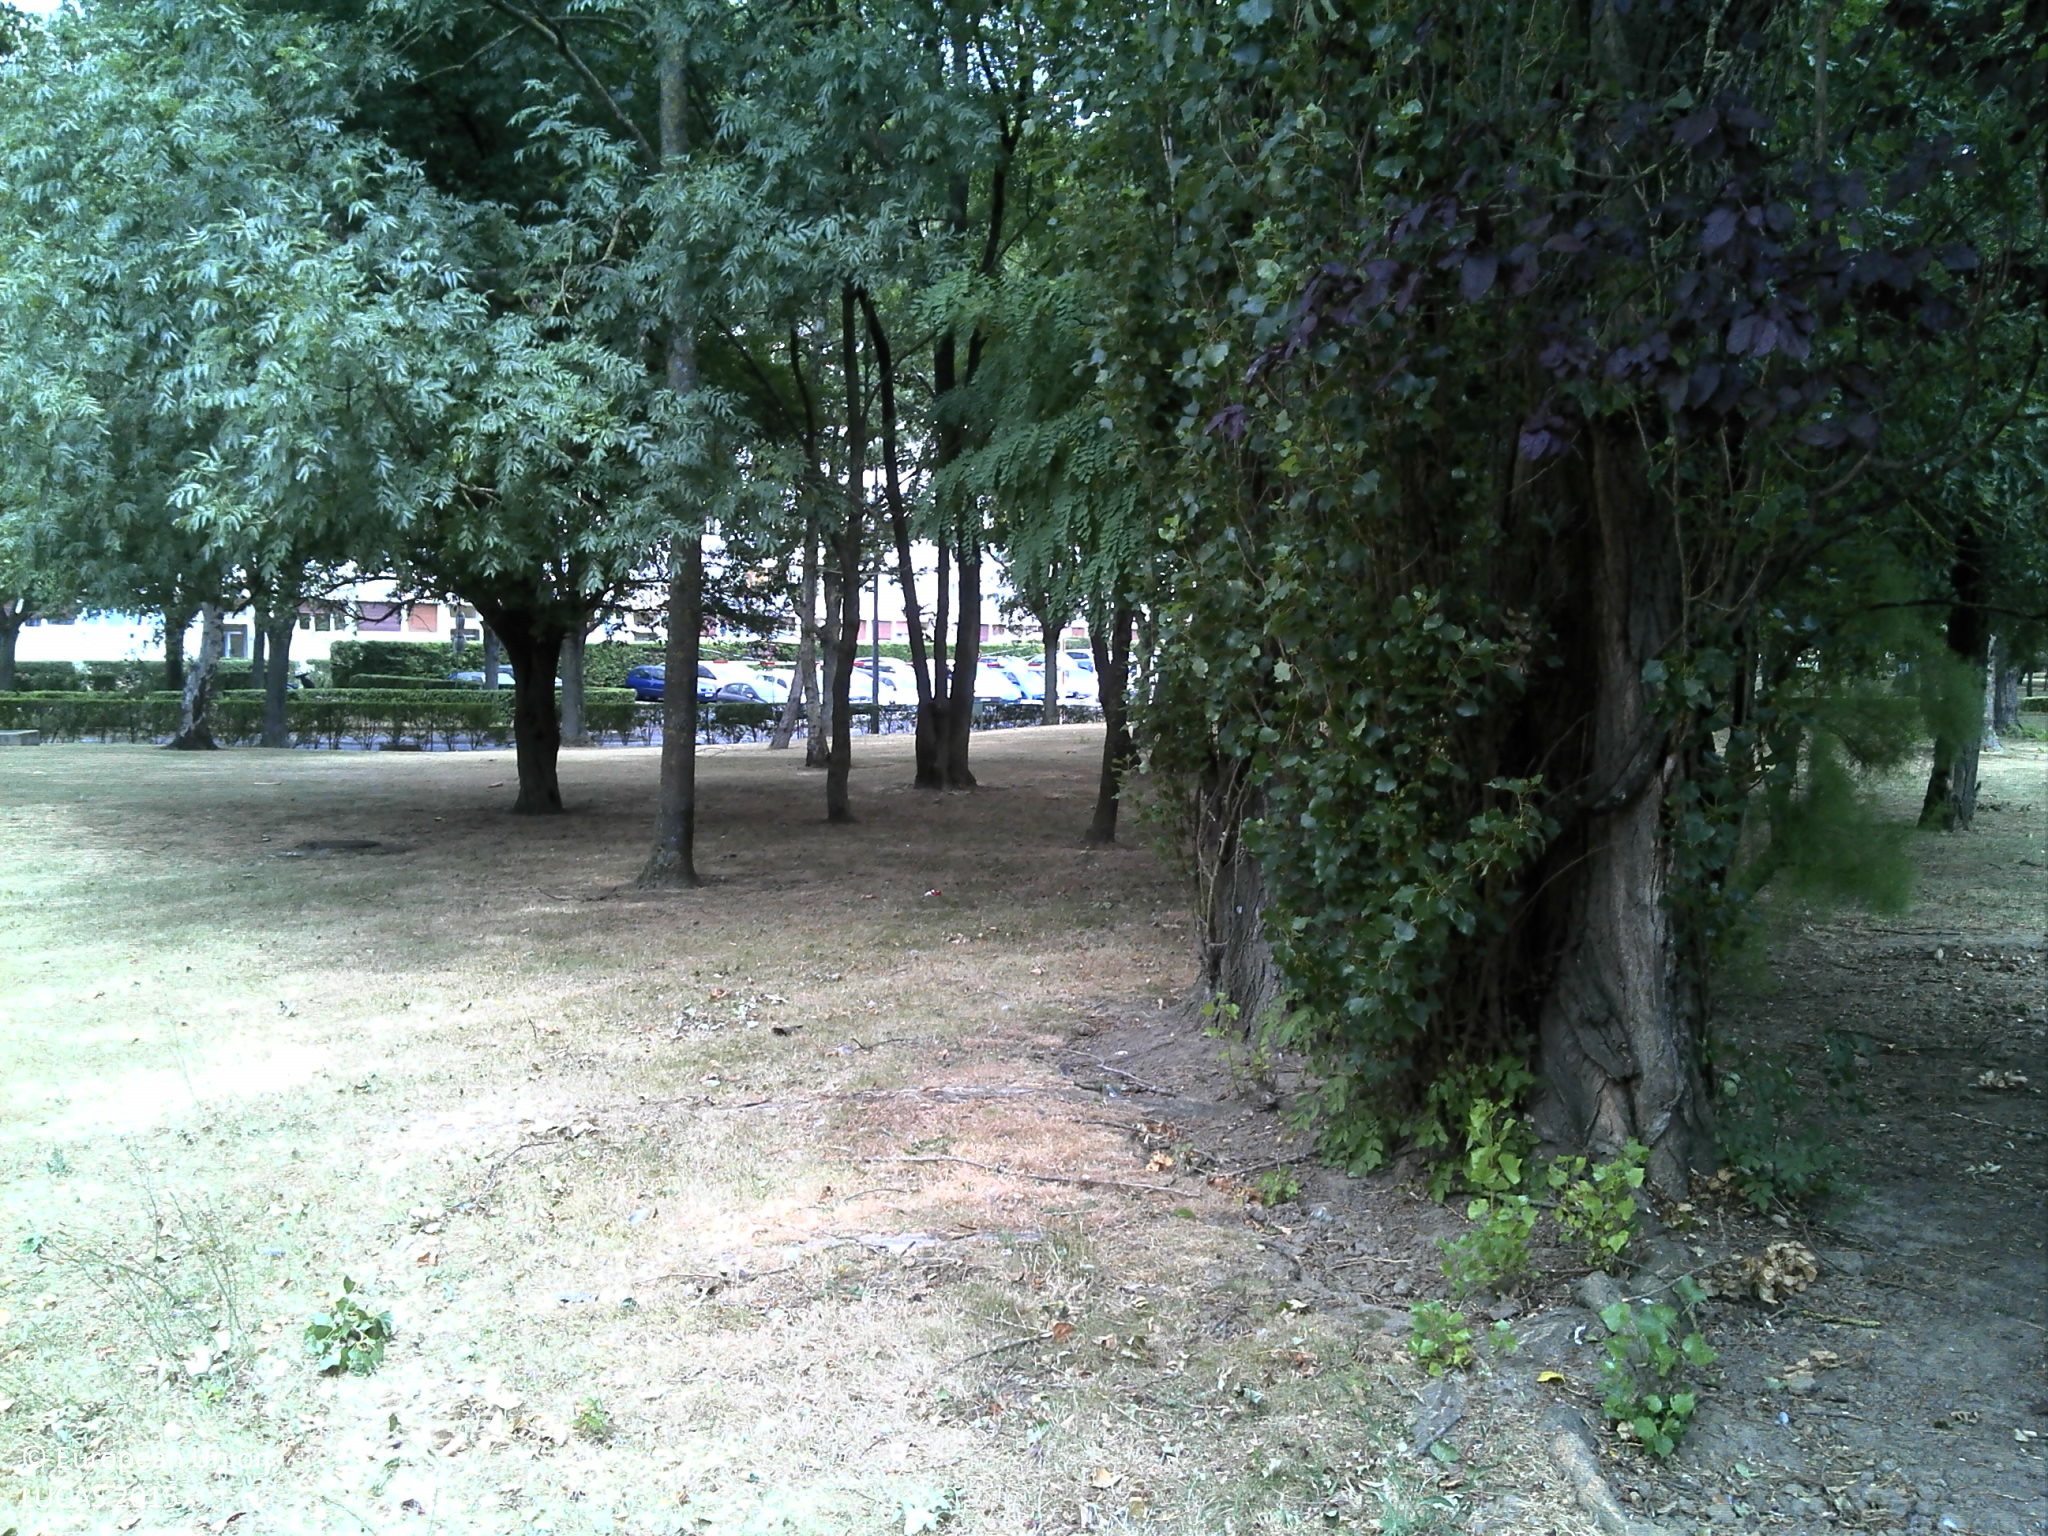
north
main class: Grassland
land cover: Grassland with sparse tree/shrub cover
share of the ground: > 75 %
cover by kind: herbaceous plants 95 %, broadleaved forest trees 5 %
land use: Residential
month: July
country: FR
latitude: 48.6478
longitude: 2.4011
